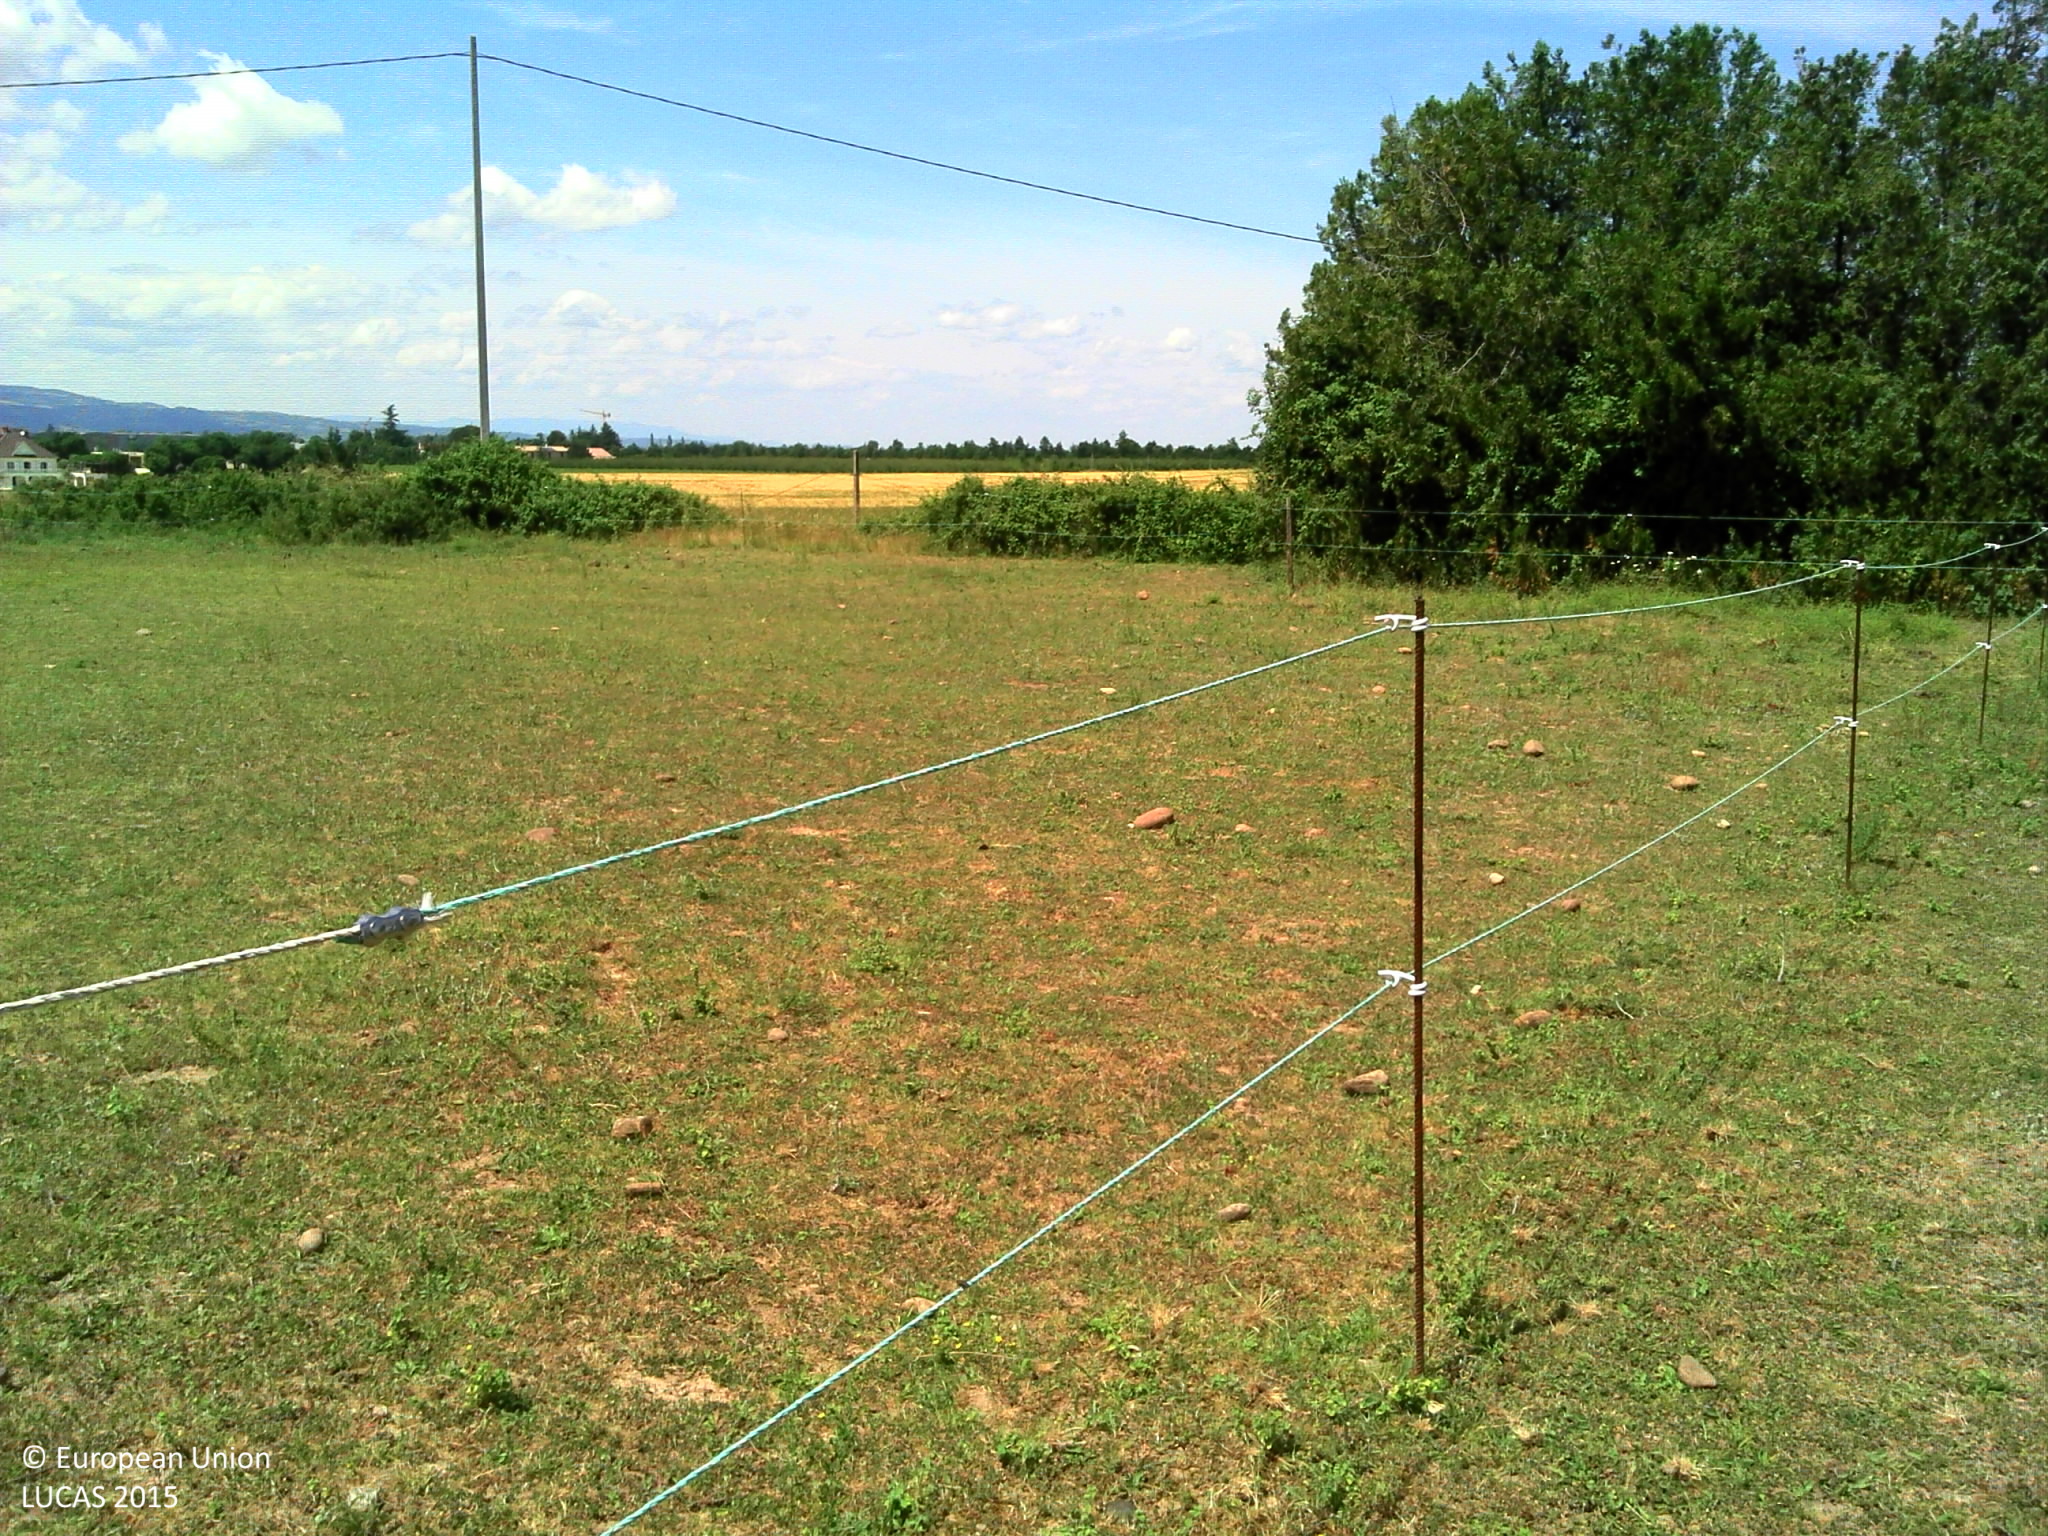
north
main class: Grassland
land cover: Grassland without tree/shrub cover
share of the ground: > 75 %
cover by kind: herbaceous plants 100 %
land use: Agriculture (excluding fallow land and kitchen gardens)
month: May
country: FR
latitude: 44.8770
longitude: 4.9297
